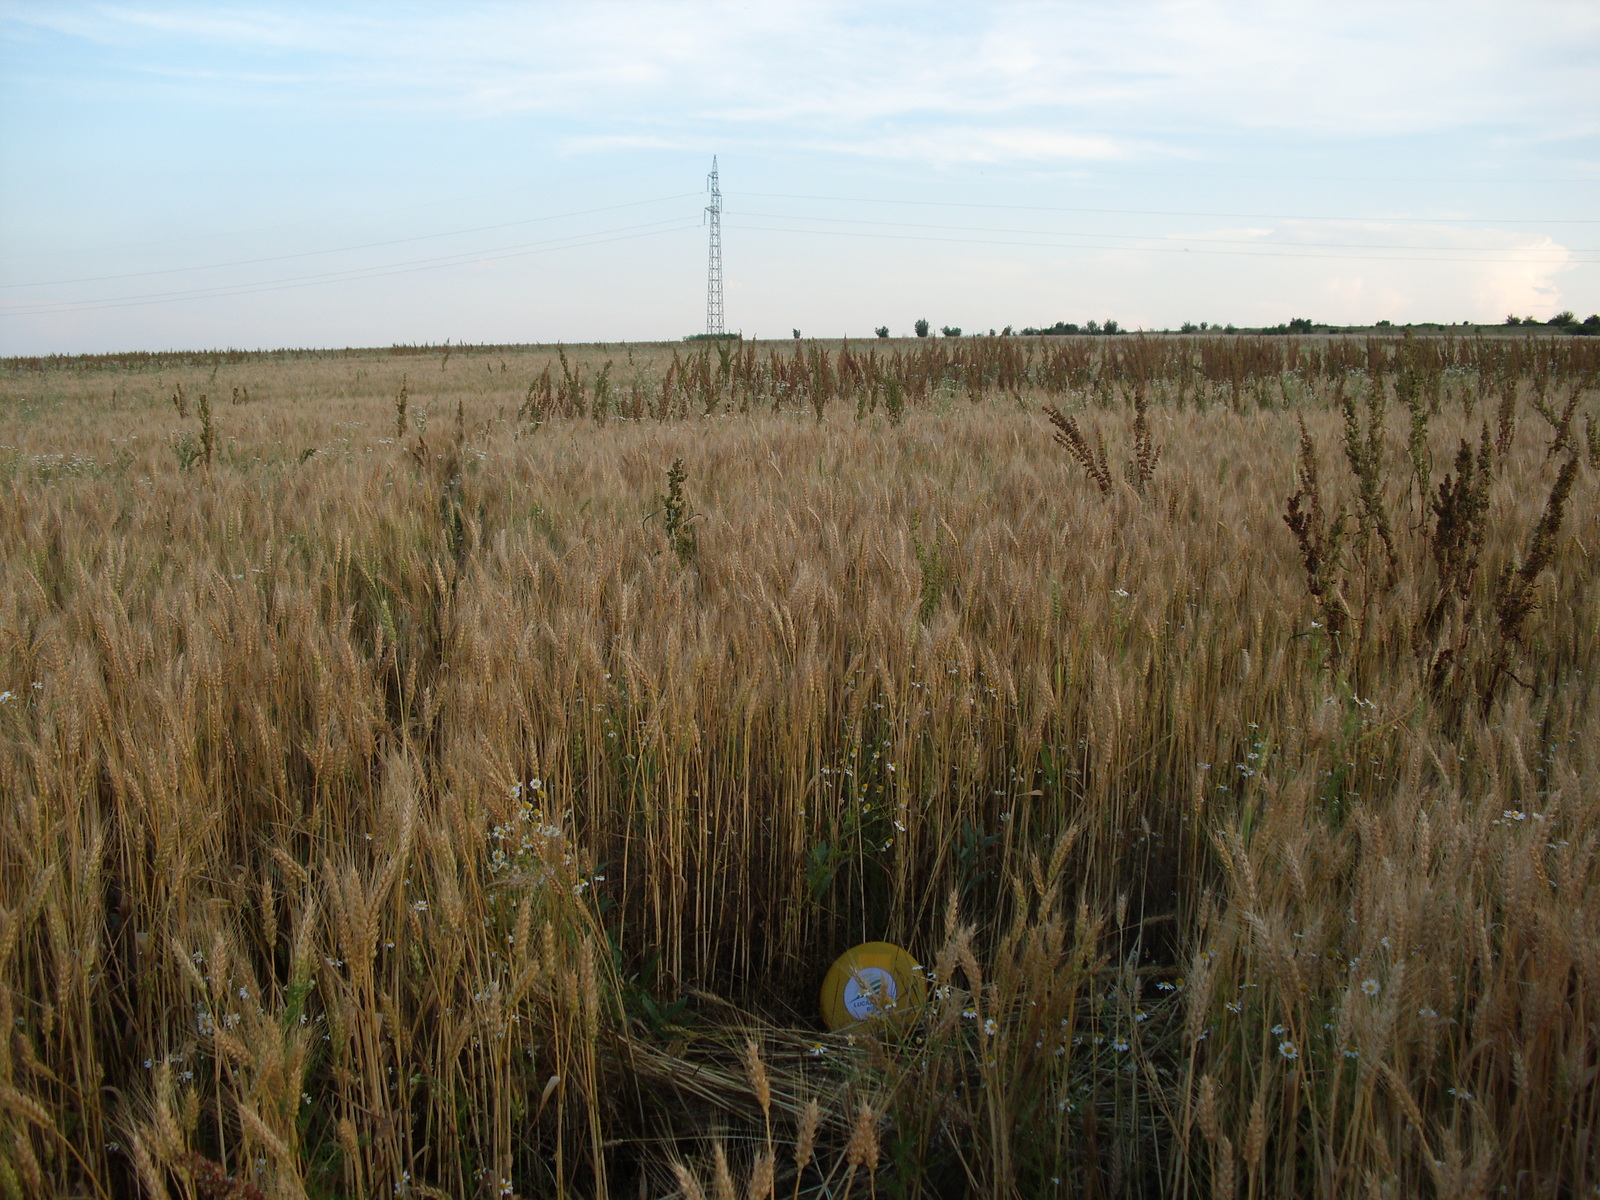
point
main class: Cropland
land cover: Common wheat
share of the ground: > 75 %
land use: Agriculture (excluding fallow land and kitchen gardens)
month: June
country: BG
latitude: 43.4357
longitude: 23.5732
